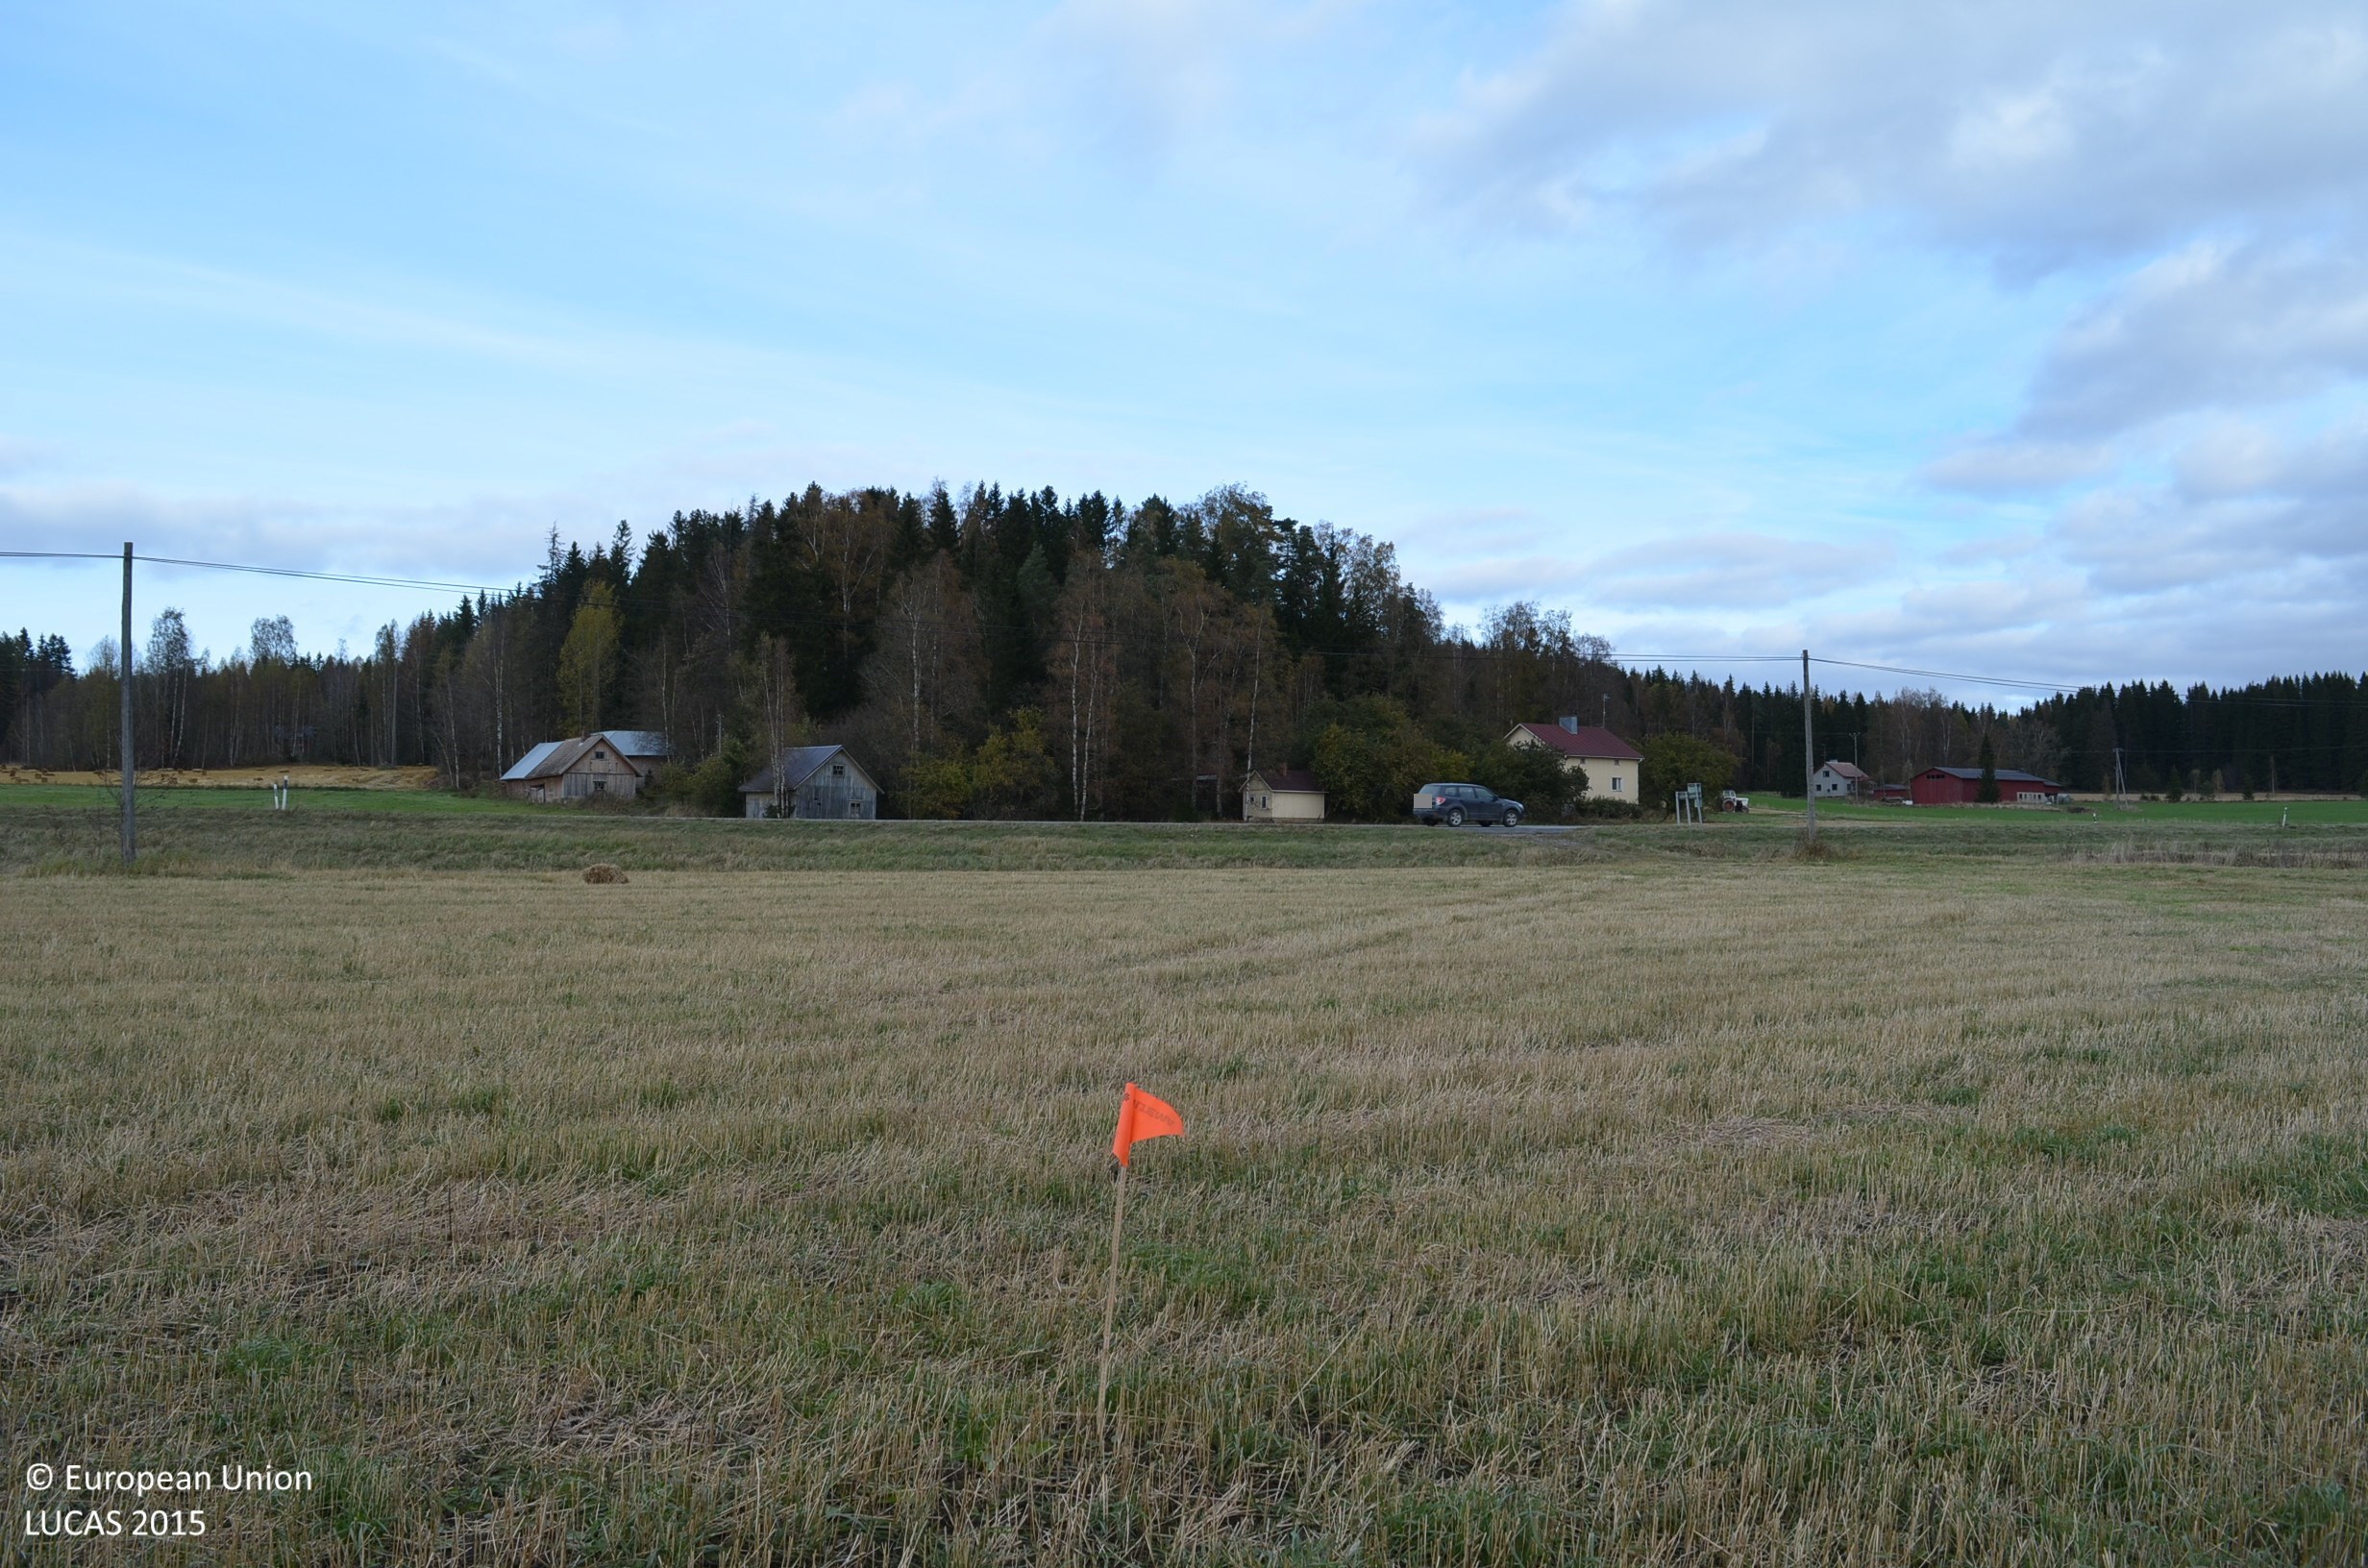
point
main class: Cropland
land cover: Barley
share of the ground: > 75 %
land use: Agriculture (excluding fallow land and kitchen gardens)
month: October
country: FI
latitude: 61.4996
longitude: 23.1679
